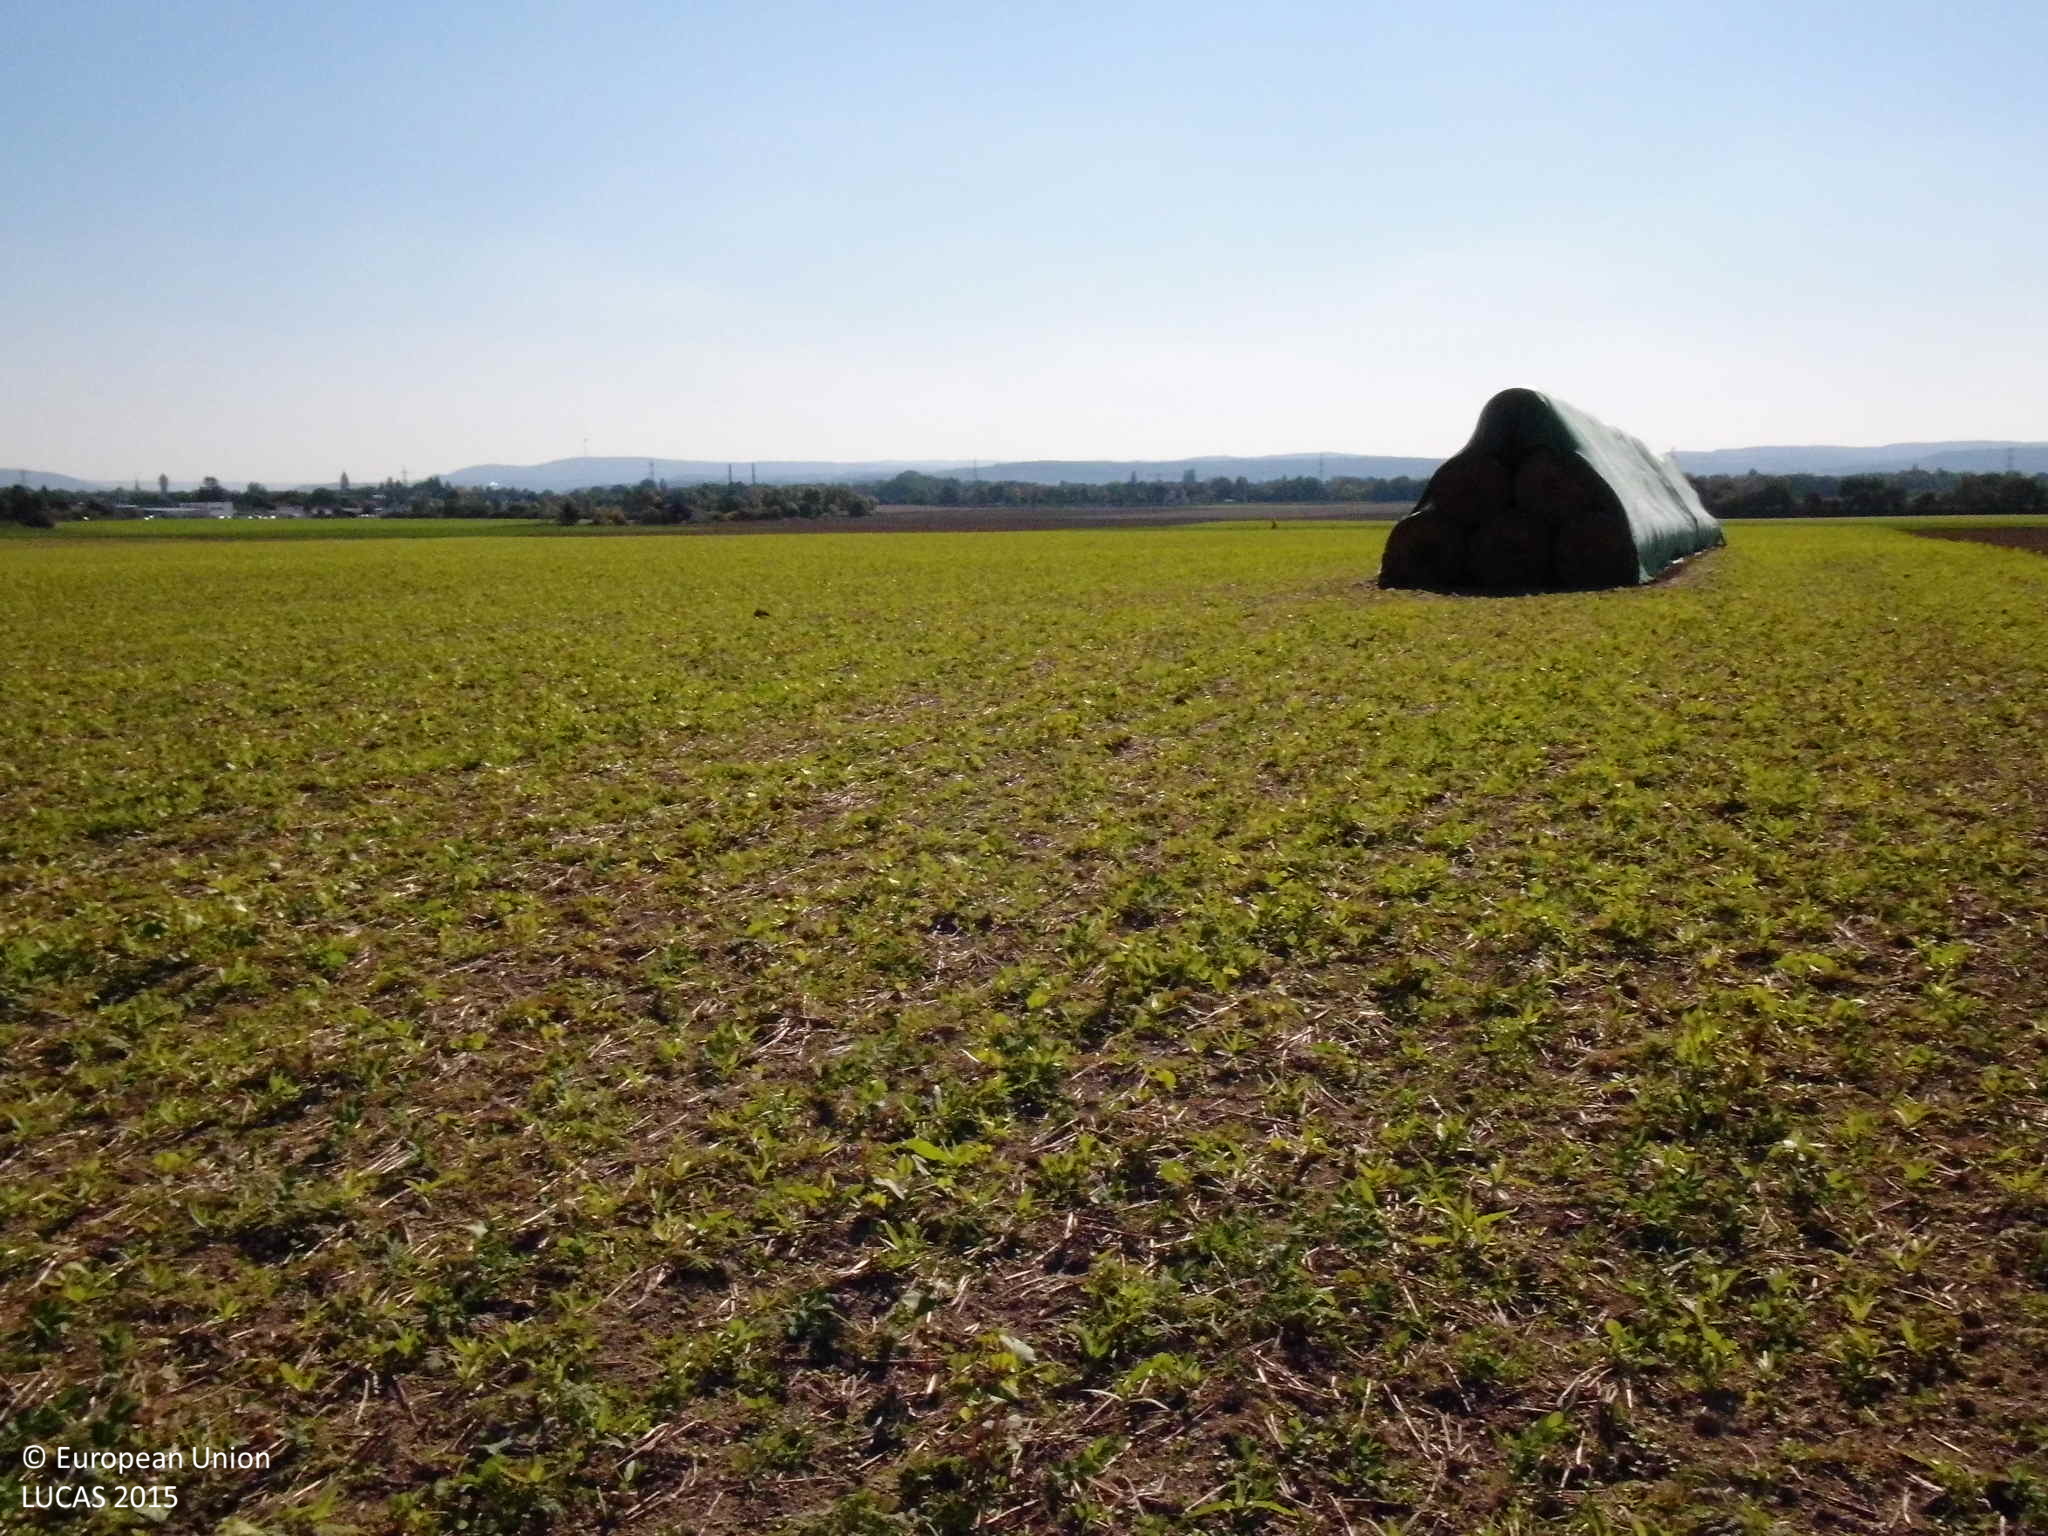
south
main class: Cropland
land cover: Other cereals
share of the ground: 10 - 25 %
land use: Agriculture (excluding fallow land and kitchen gardens)
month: October
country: DE
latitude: 50.4455
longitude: 7.5359
